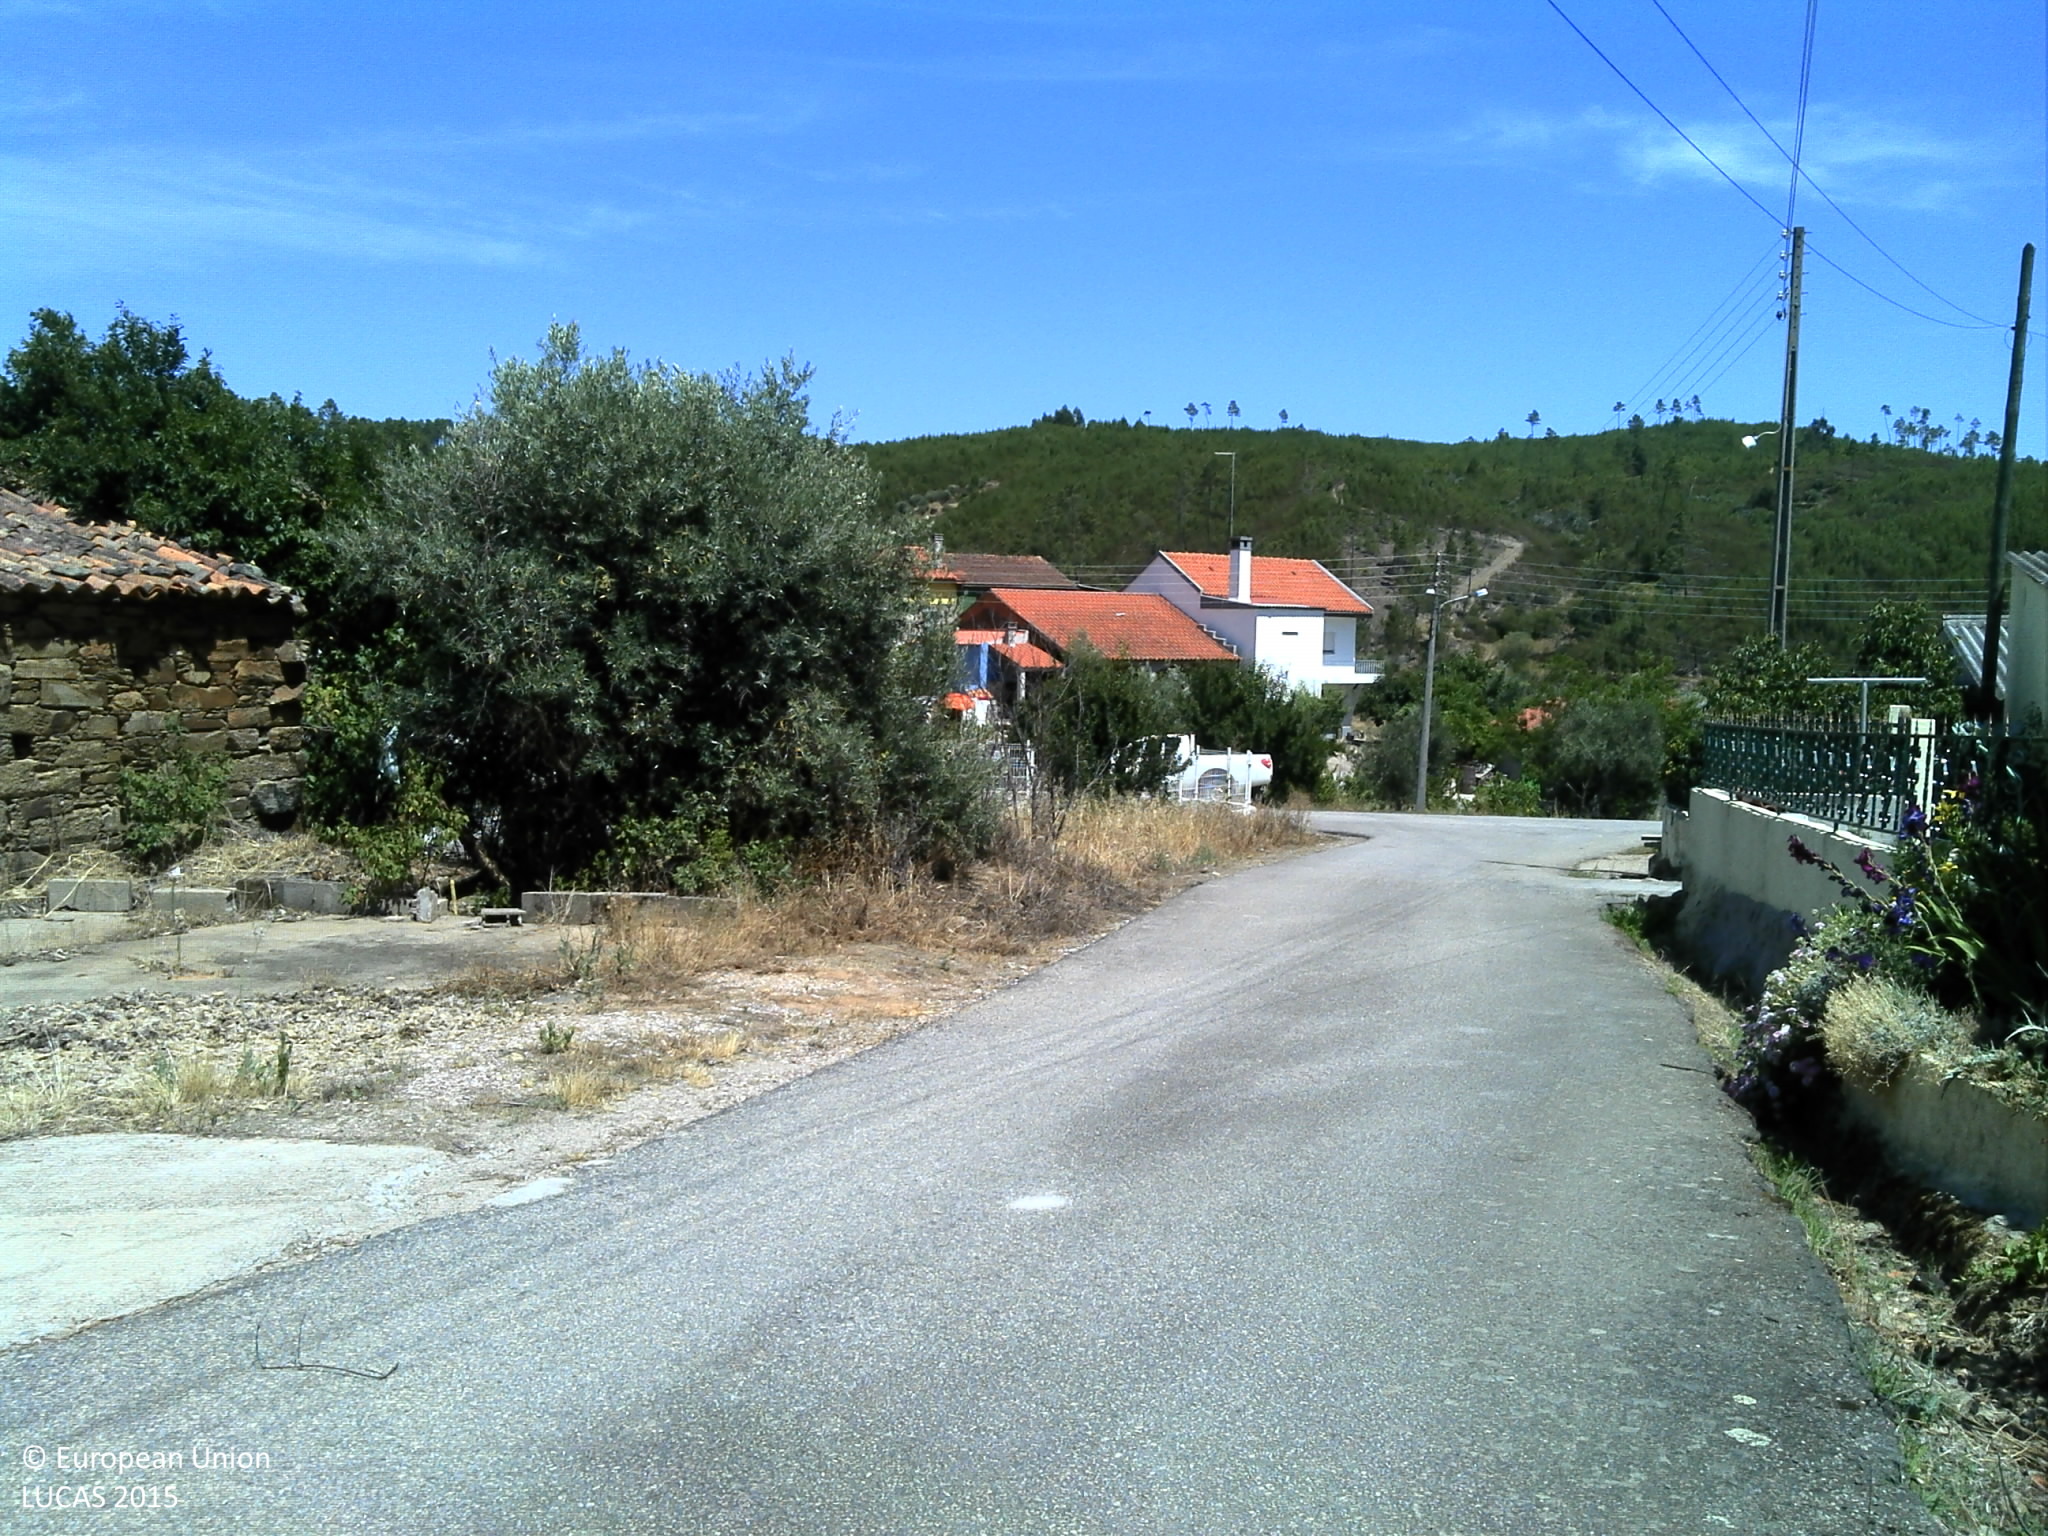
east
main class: Cropland
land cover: Apple fruit
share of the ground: 10 - 25 %
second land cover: Other fresh vegetables
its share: 10 - 25 %
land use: Kitchen garden
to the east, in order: Apple fruit; Other fresh vegetables; Apple fruit; Artificial constructions; Grass margins; Electric lines; Paved roads, cycling and walking lanes; Electric lines; Other fruit trees and berries; Artificial constructions; Other fresh vegetables; Dry pulses; Artificial constructions; Paved roads, cycling and walking lanes; Other fruit trees and berries; Electric lines; Potatoes; Vineyards; Olive groves; Artificial constructions in urban areas; Vineyards; Electric lines; Spontaneously vegetated surfaces; Olive groves; Artificial constructions; Tracks; Spontaneously vegetated surfaces; Dry stone walls; Spontaneously vegetated surfaces; Olive groves; Dry stone walls; Grass margins; Tracks; Olive groves; Dry stone walls; Olive groves; Dry stone walls; Ditches and canals; Tomatoes; Maize; Vineyards; Abandoned hedges; Rivers and streams; Abandoned hedges; Olive groves; Shrubland without tree cover; Dry stone walls; Shrubland without tree cover; Shrubland with sparse tree cover
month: July
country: PT
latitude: 39.8150
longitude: -7.7566
